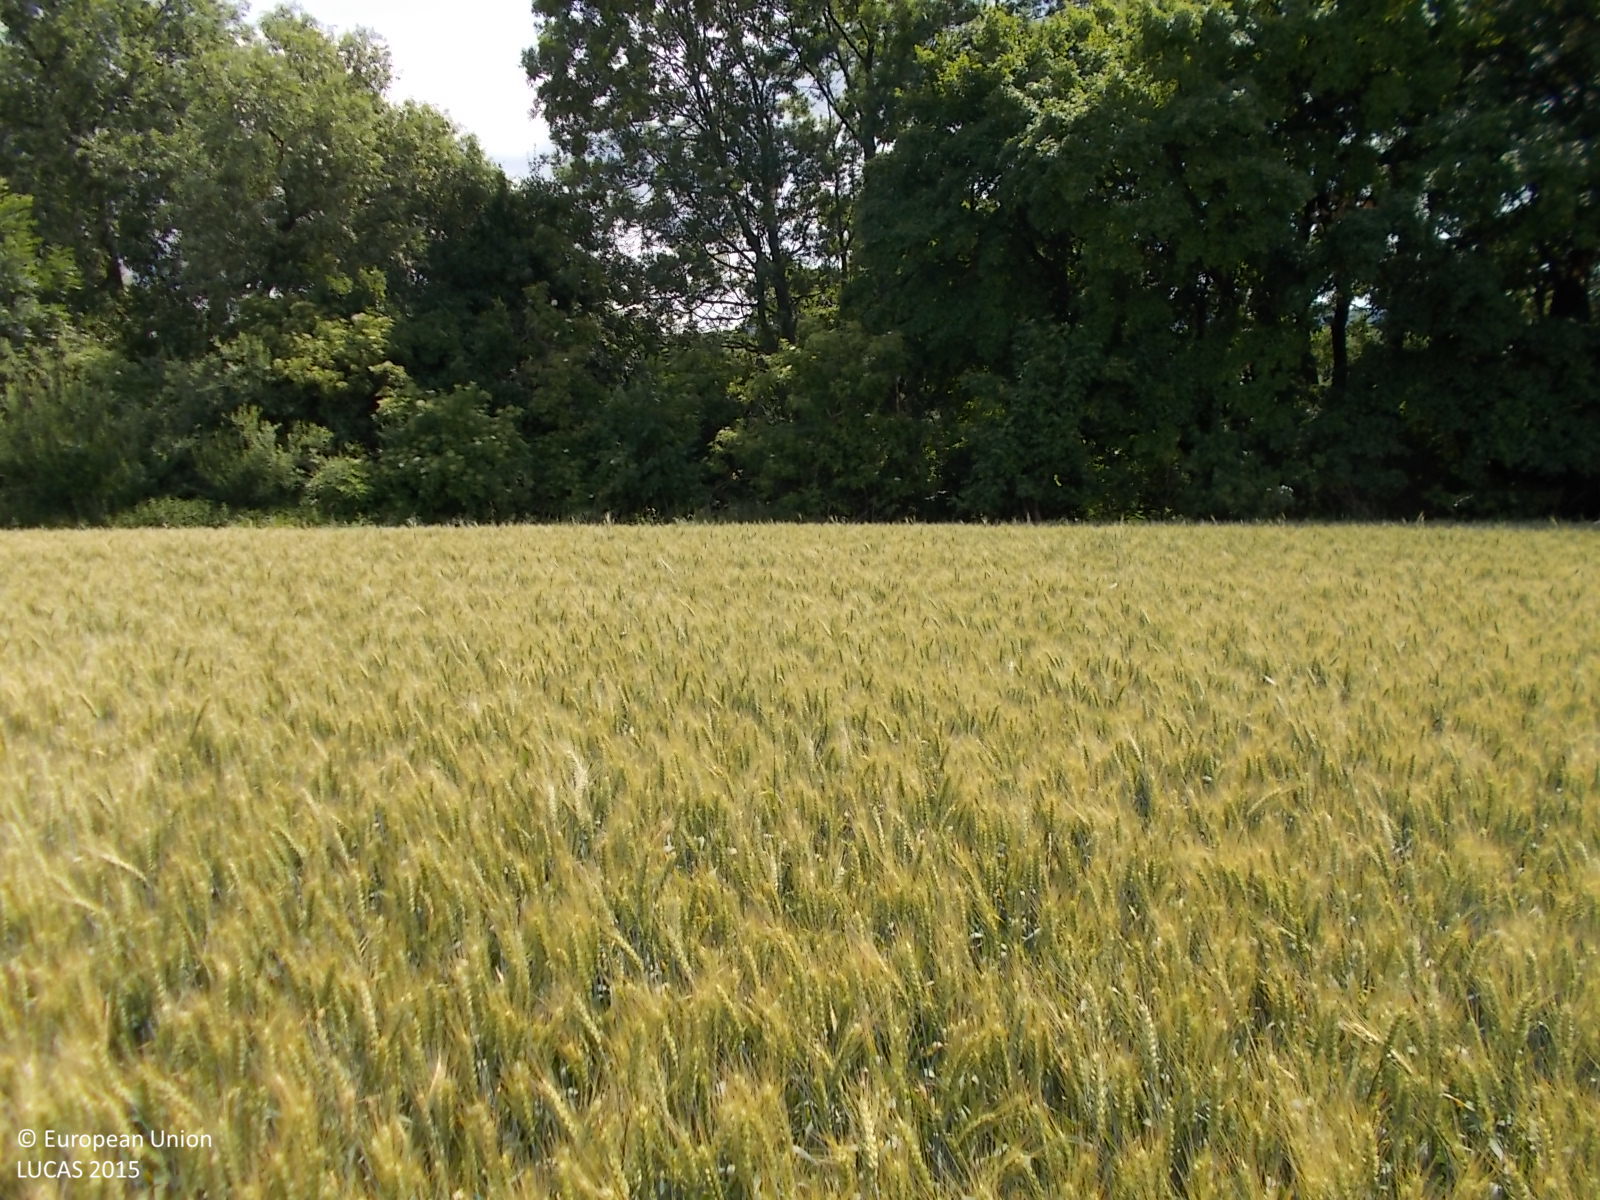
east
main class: Cropland
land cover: Common wheat
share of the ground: > 75 %
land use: Agriculture (excluding fallow land and kitchen gardens)
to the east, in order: Common wheat; Grass margins; Broadleaved woodland; Ditches and canals; Broadleaved woodland; Common wheat
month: June
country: CZ
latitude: 49.3525
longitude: 17.5978
